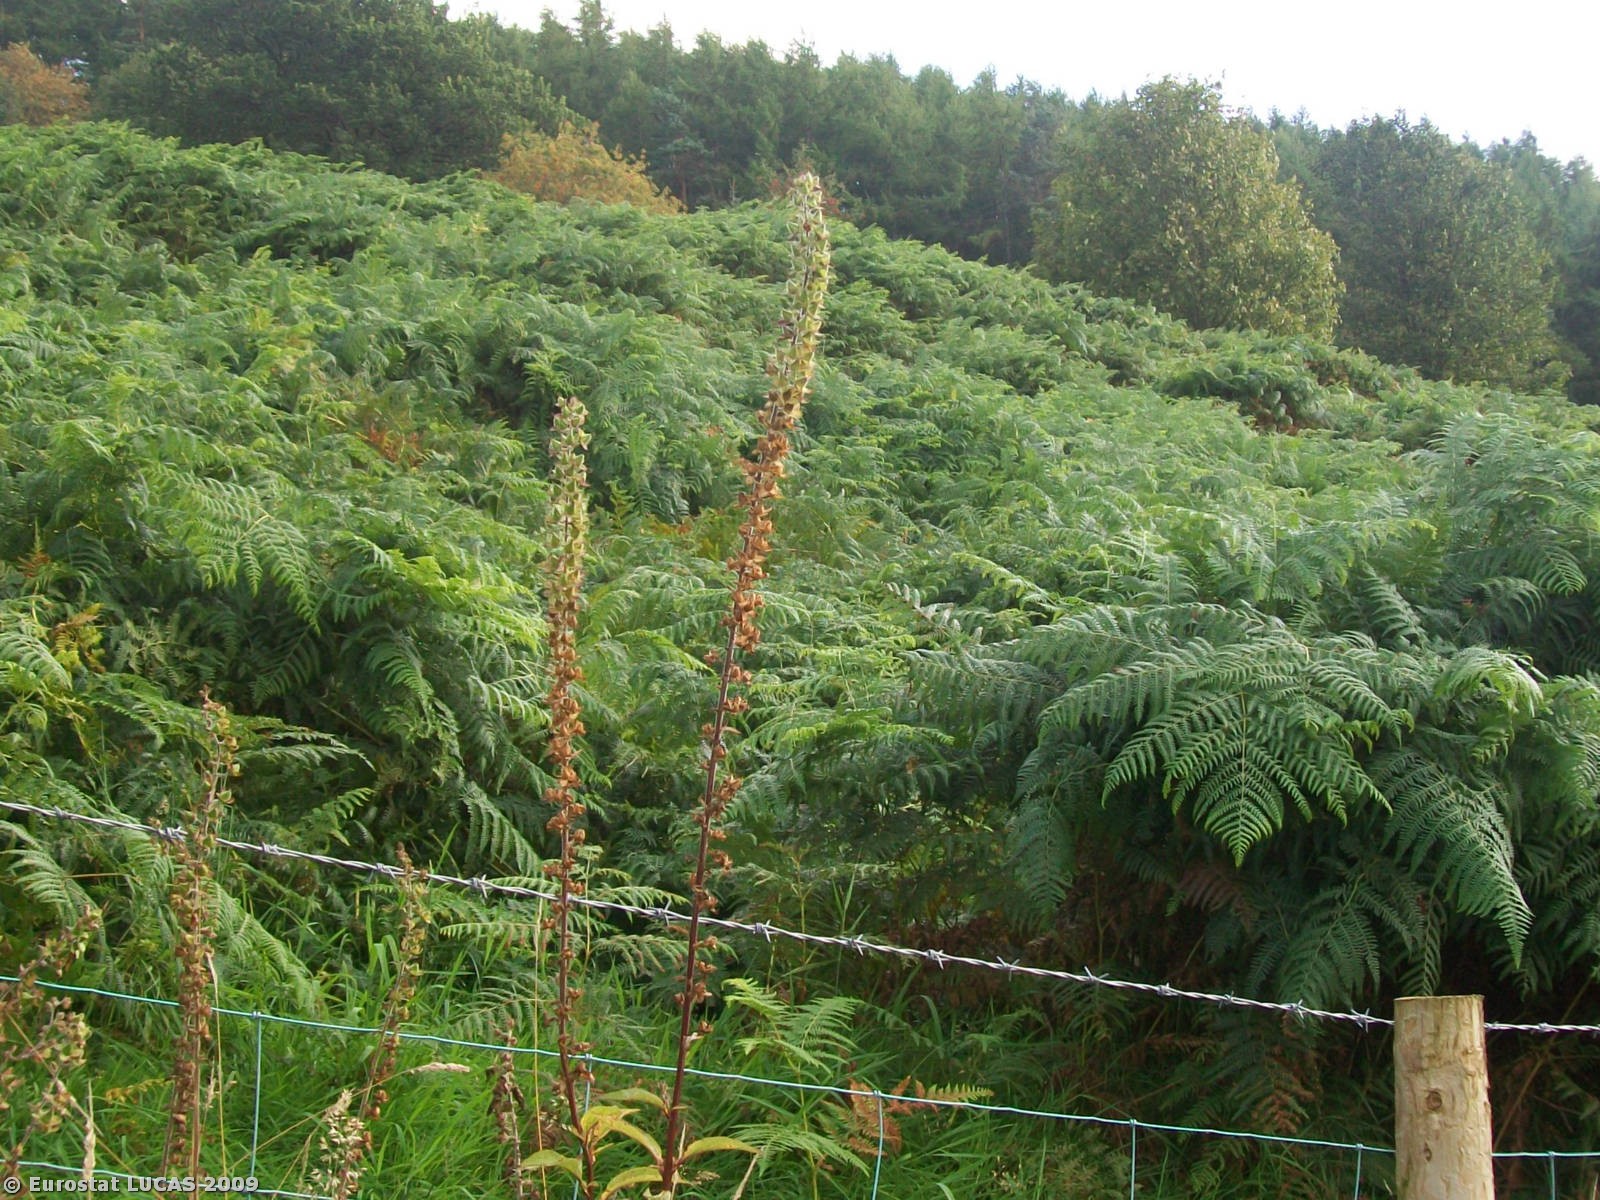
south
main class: Shrubland
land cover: Shrubland without tree cover
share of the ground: > 75 %
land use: Agriculture (excluding fallow land and kitchen gardens)
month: August
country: GB
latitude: 52.9202
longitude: -3.4542
